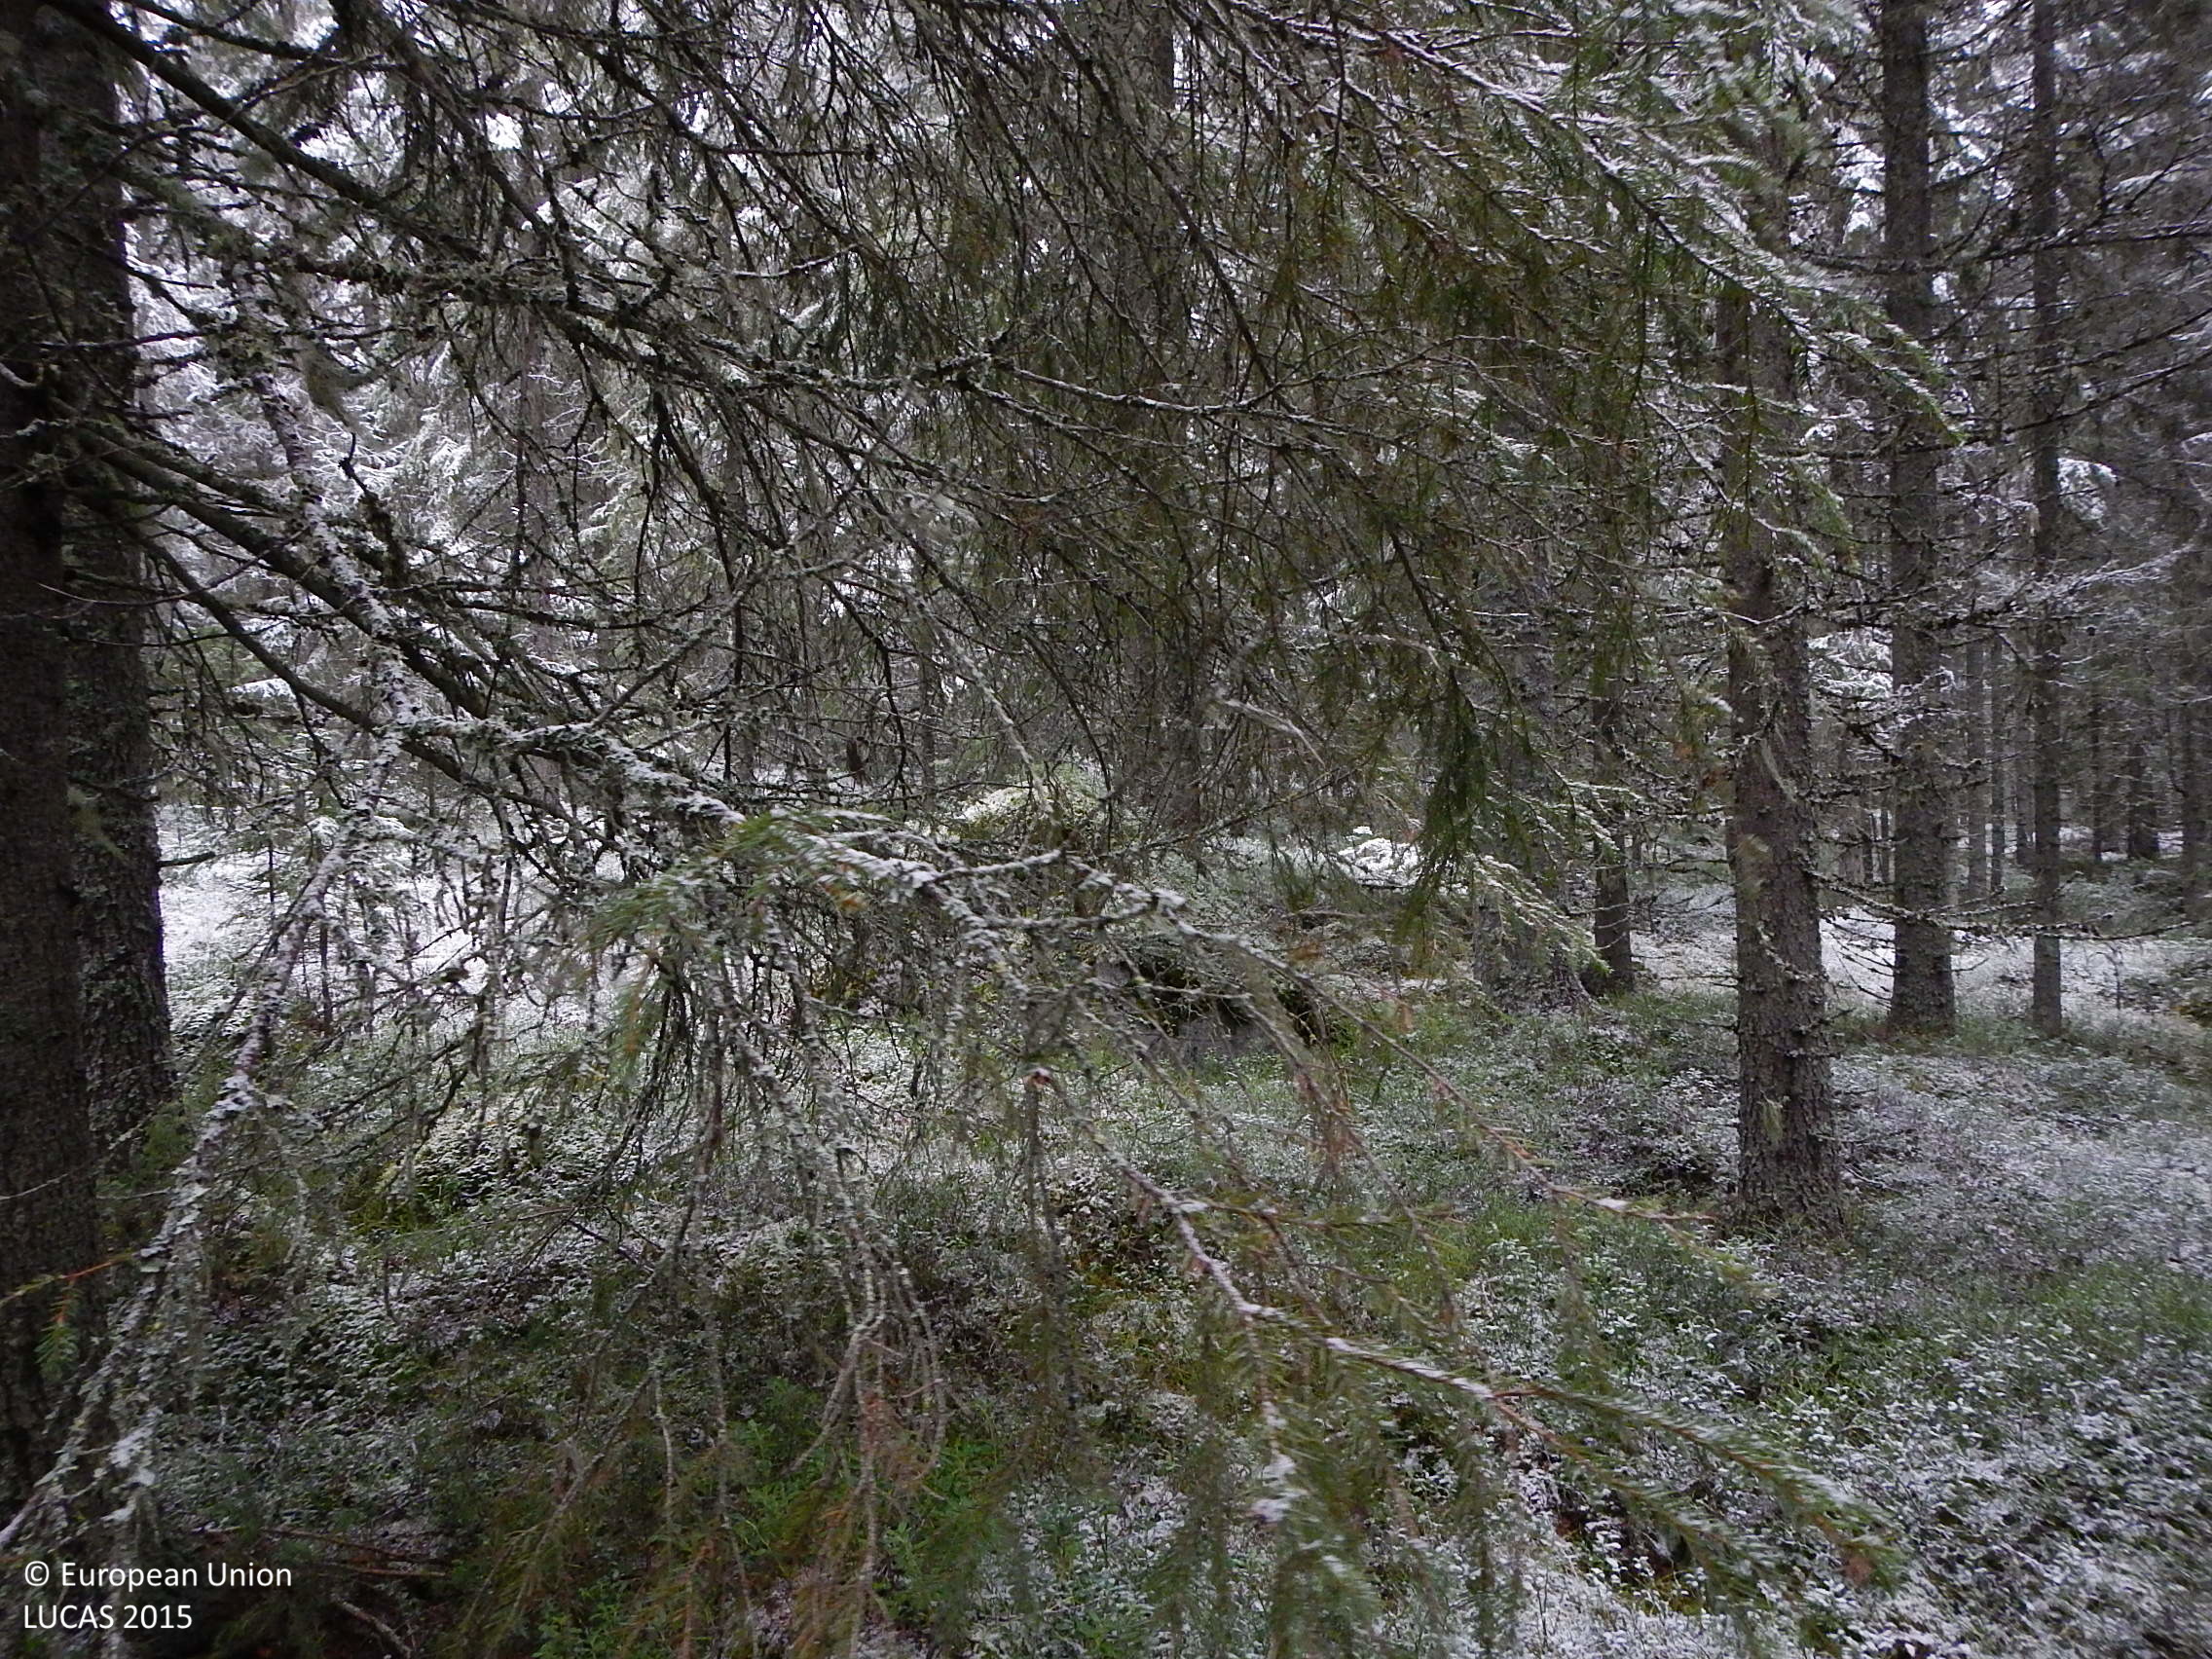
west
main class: Woodland
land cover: Spruce dominated coniferous woodland
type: boreal forest
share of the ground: > 75 %
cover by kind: coniferous forest trees 80 %, shrubs 10 %, lichens and mosses 10 %
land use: Forestry
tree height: > 5 m
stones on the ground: < 10 %
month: November
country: SE
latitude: 61.7904
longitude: 15.4633
